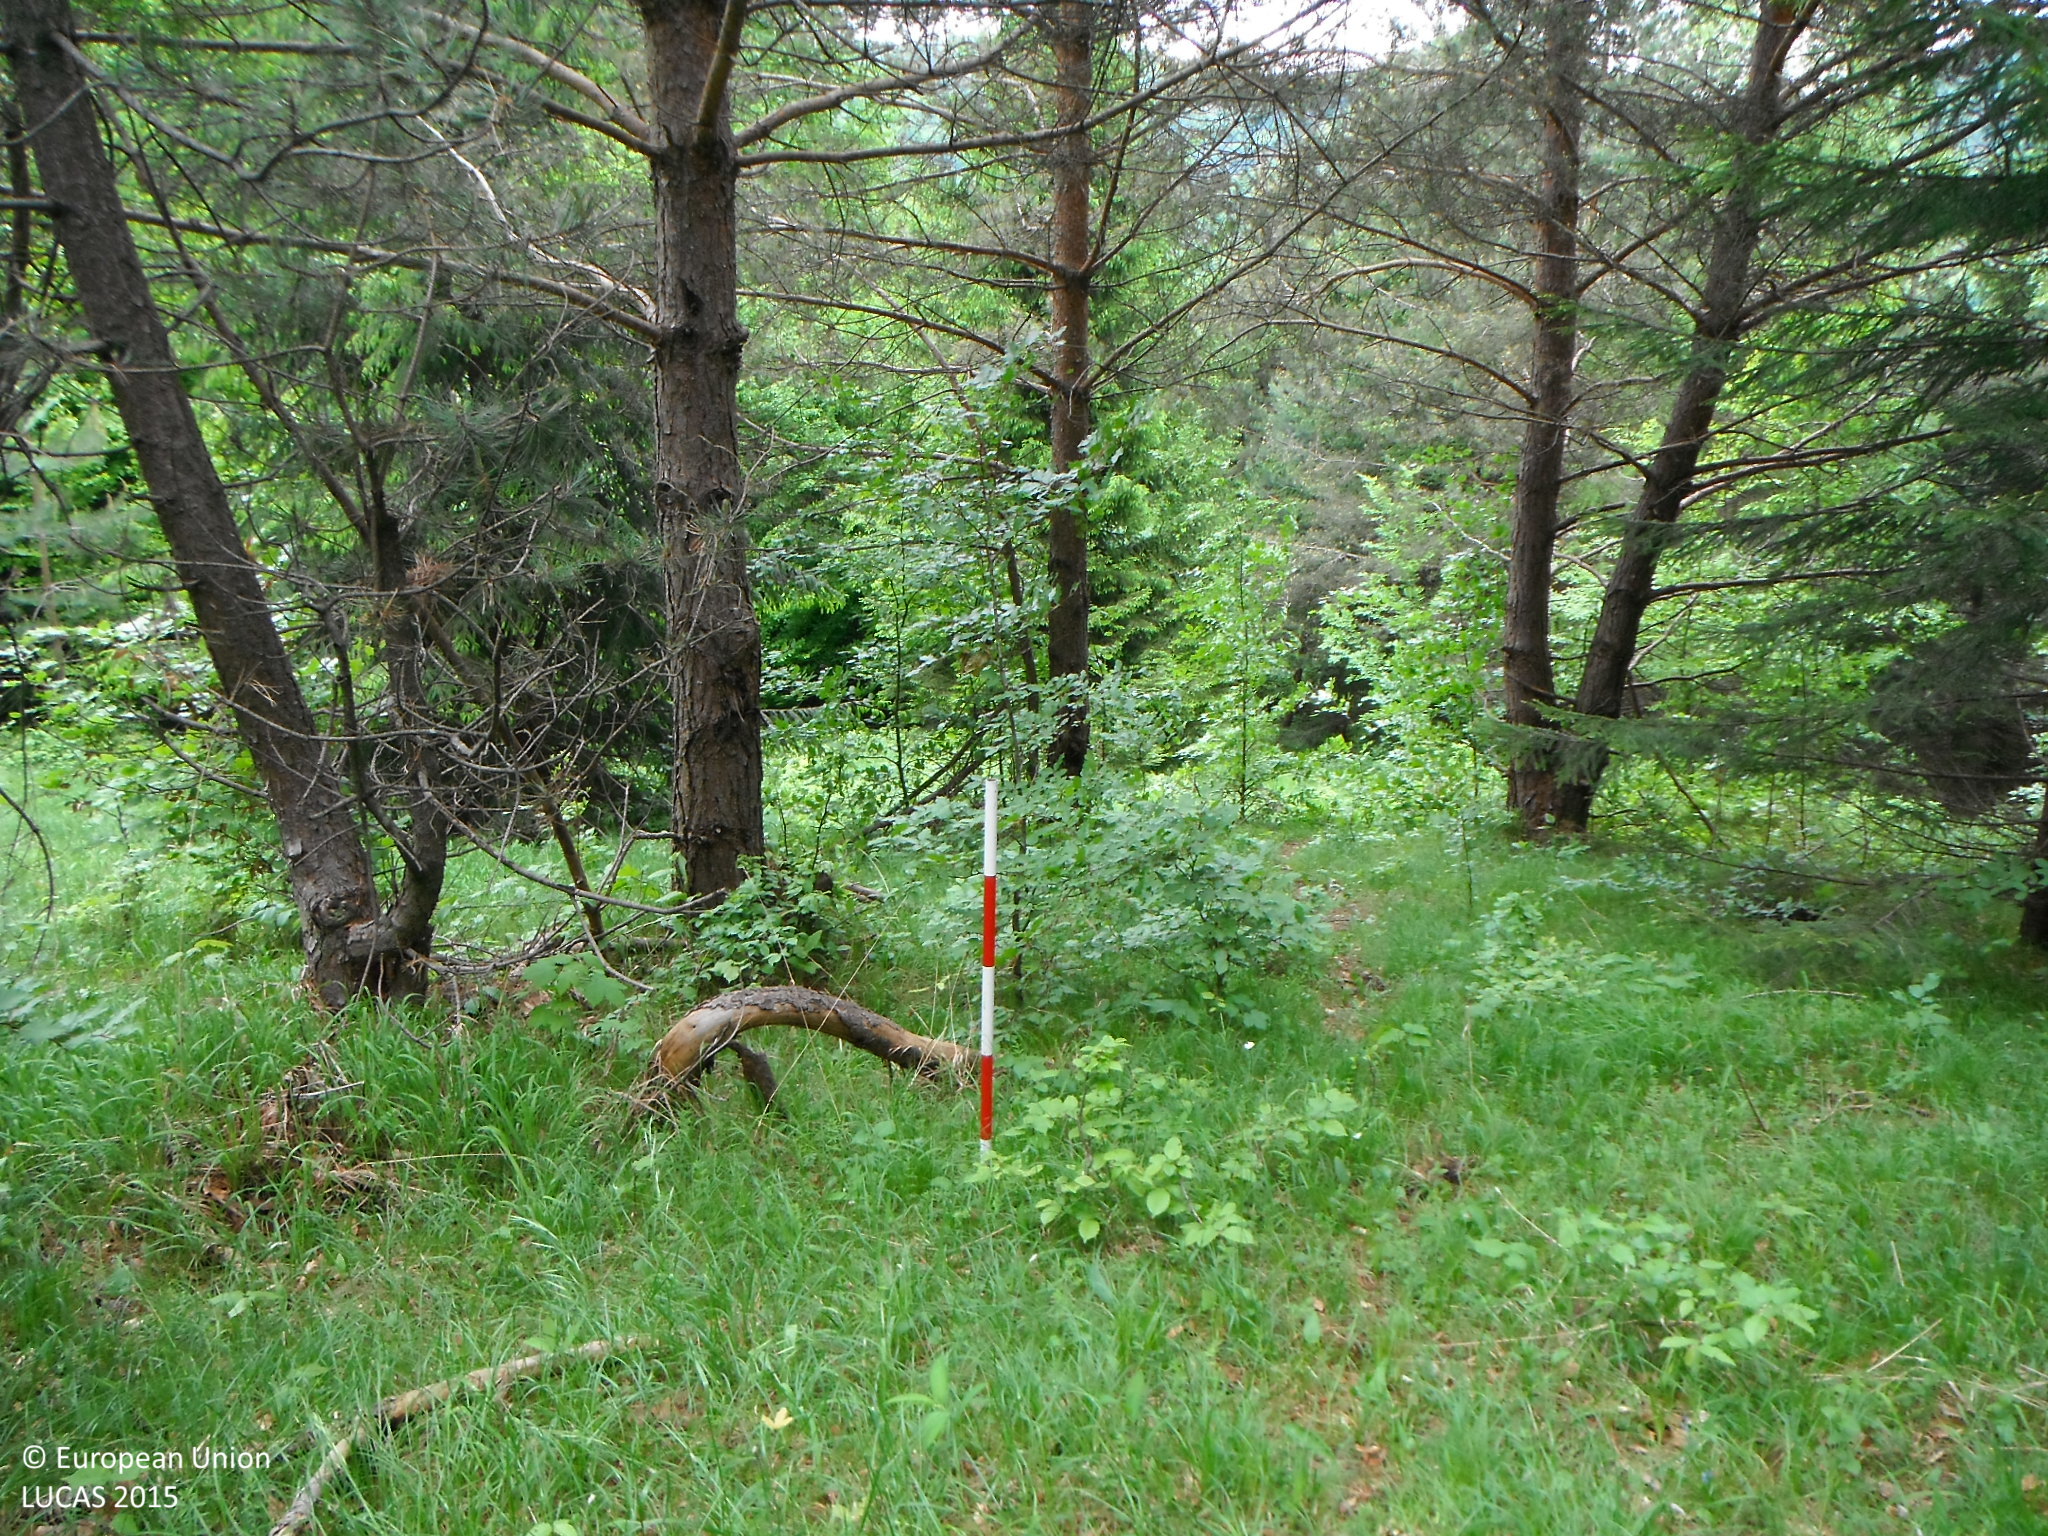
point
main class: Woodland
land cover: Pine dominated mixed woodland
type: hemiboreal forest and nemoral coniferous forest and mixed broadleaved-coniferous forest
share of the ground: > 75 %
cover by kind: broadleaved forest trees 55 %, coniferous forest trees 40 %, herbaceous plants 5 %
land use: Forestry
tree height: > 5 m
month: May
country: SK
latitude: 48.7545
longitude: 19.0670
